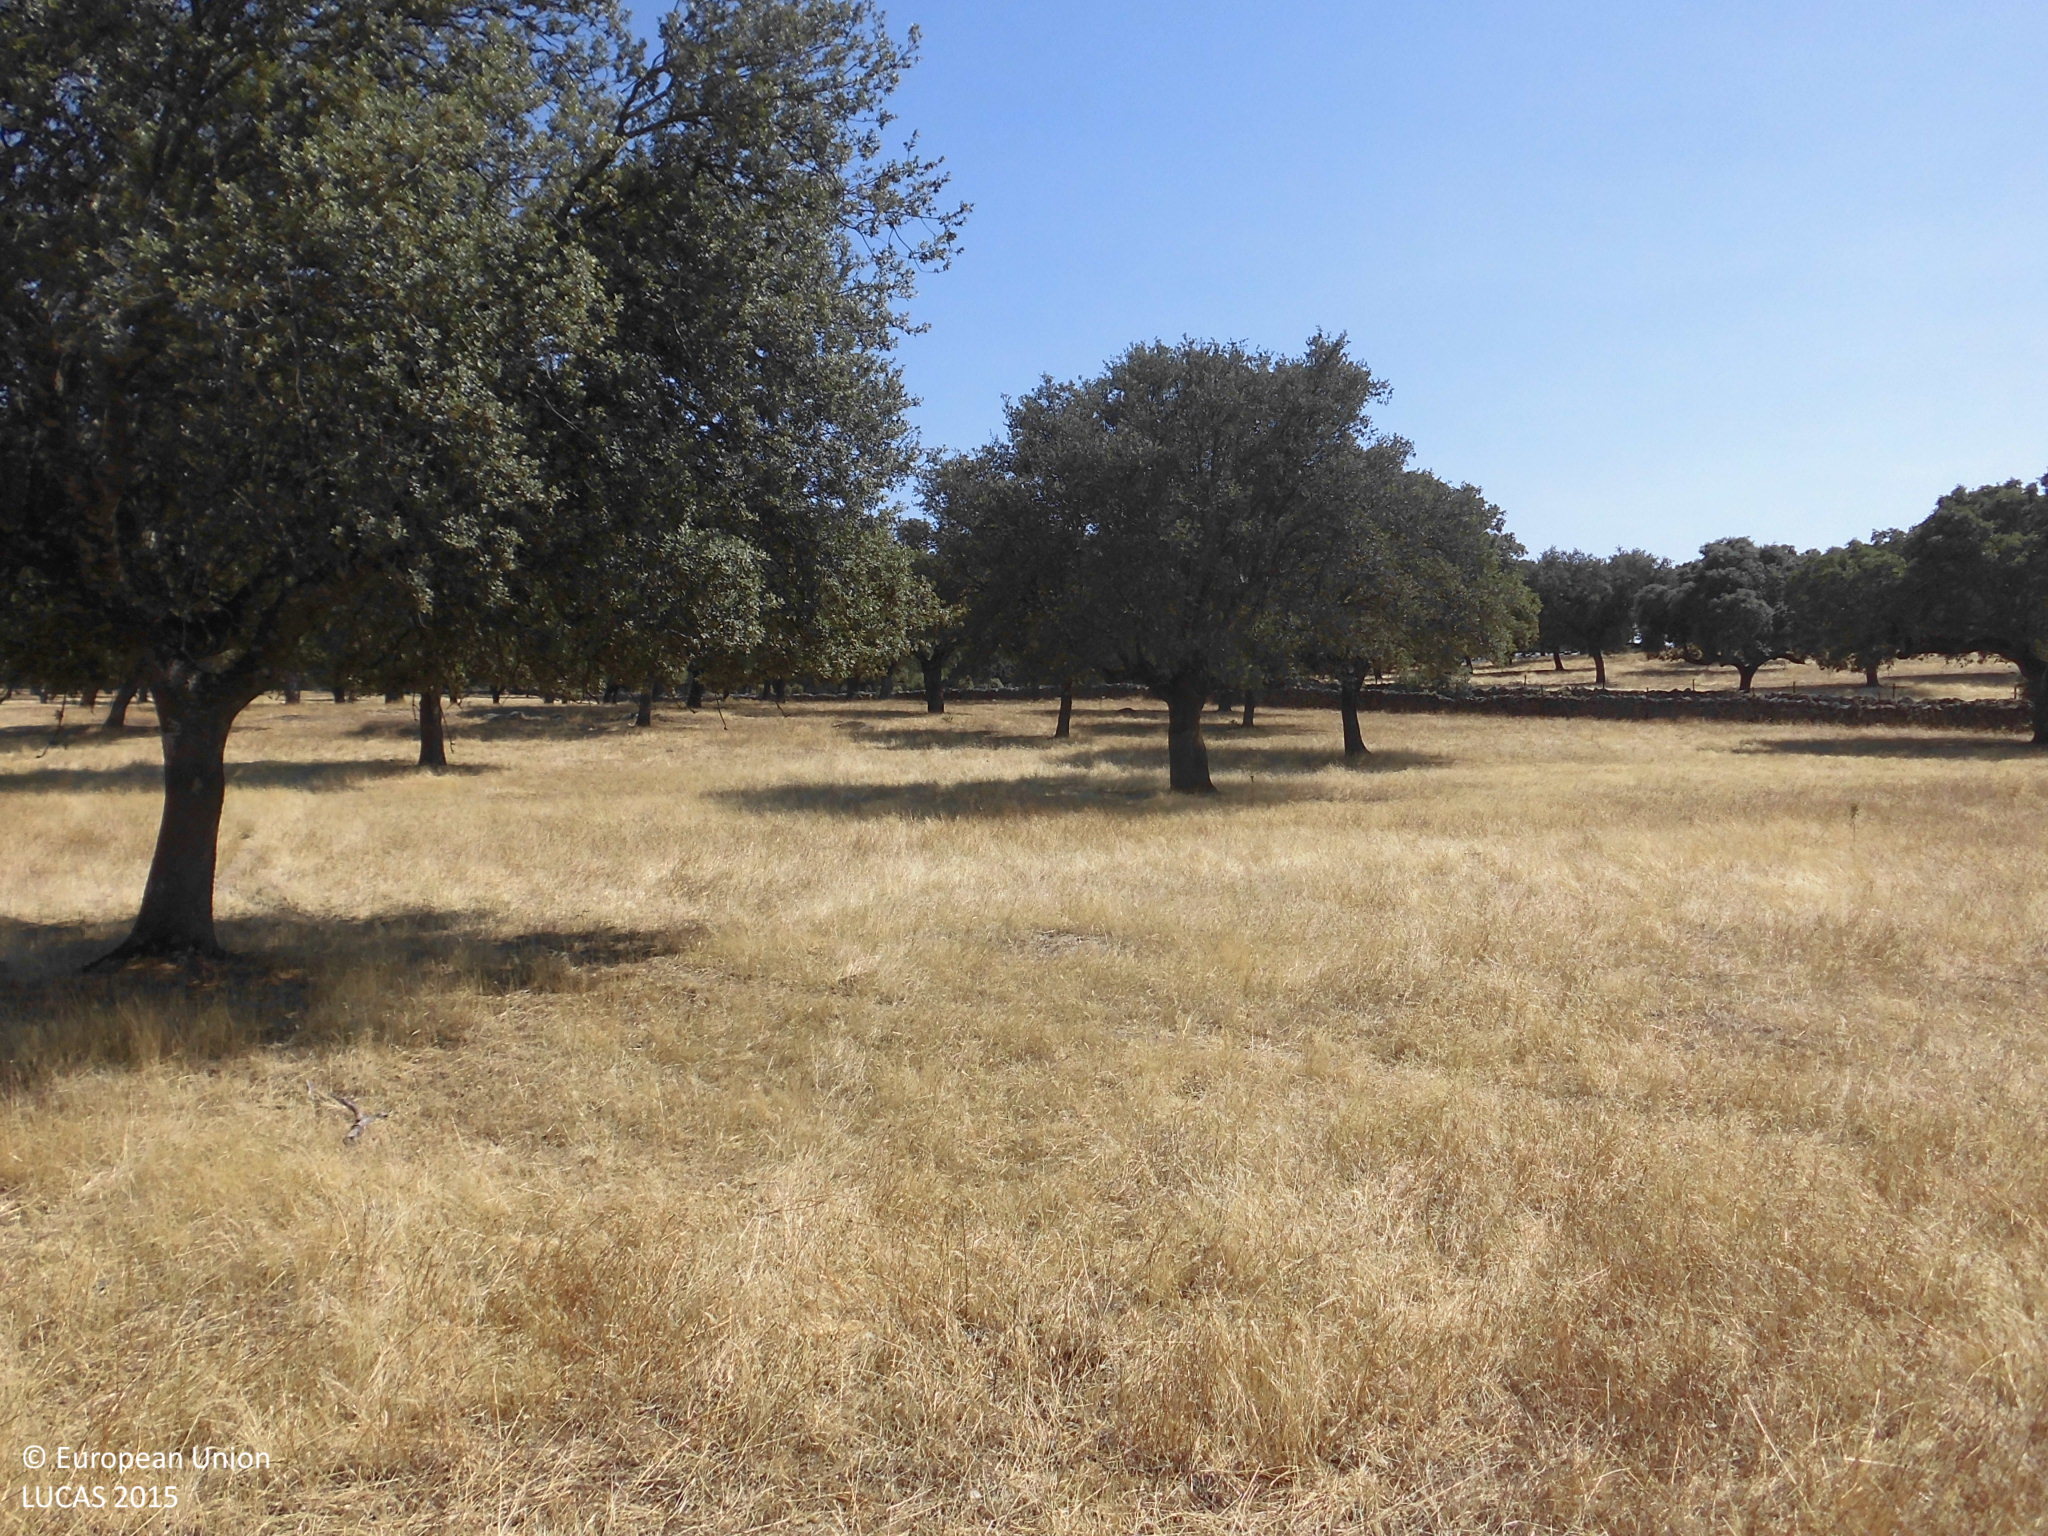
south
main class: Woodland
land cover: Broadleaved woodland
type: broadleaved evergreen forest
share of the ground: 25 - 50 %
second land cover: Grassland without tree/shrub cover
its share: > 75 %
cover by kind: herbaceous plants 70 %, broadleaved forest trees 30 %
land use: Forestry
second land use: Agriculture (excluding fallow land and kitchen gardens)
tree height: > 5 m
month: July
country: ES
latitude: 40.1609
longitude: -6.1000
